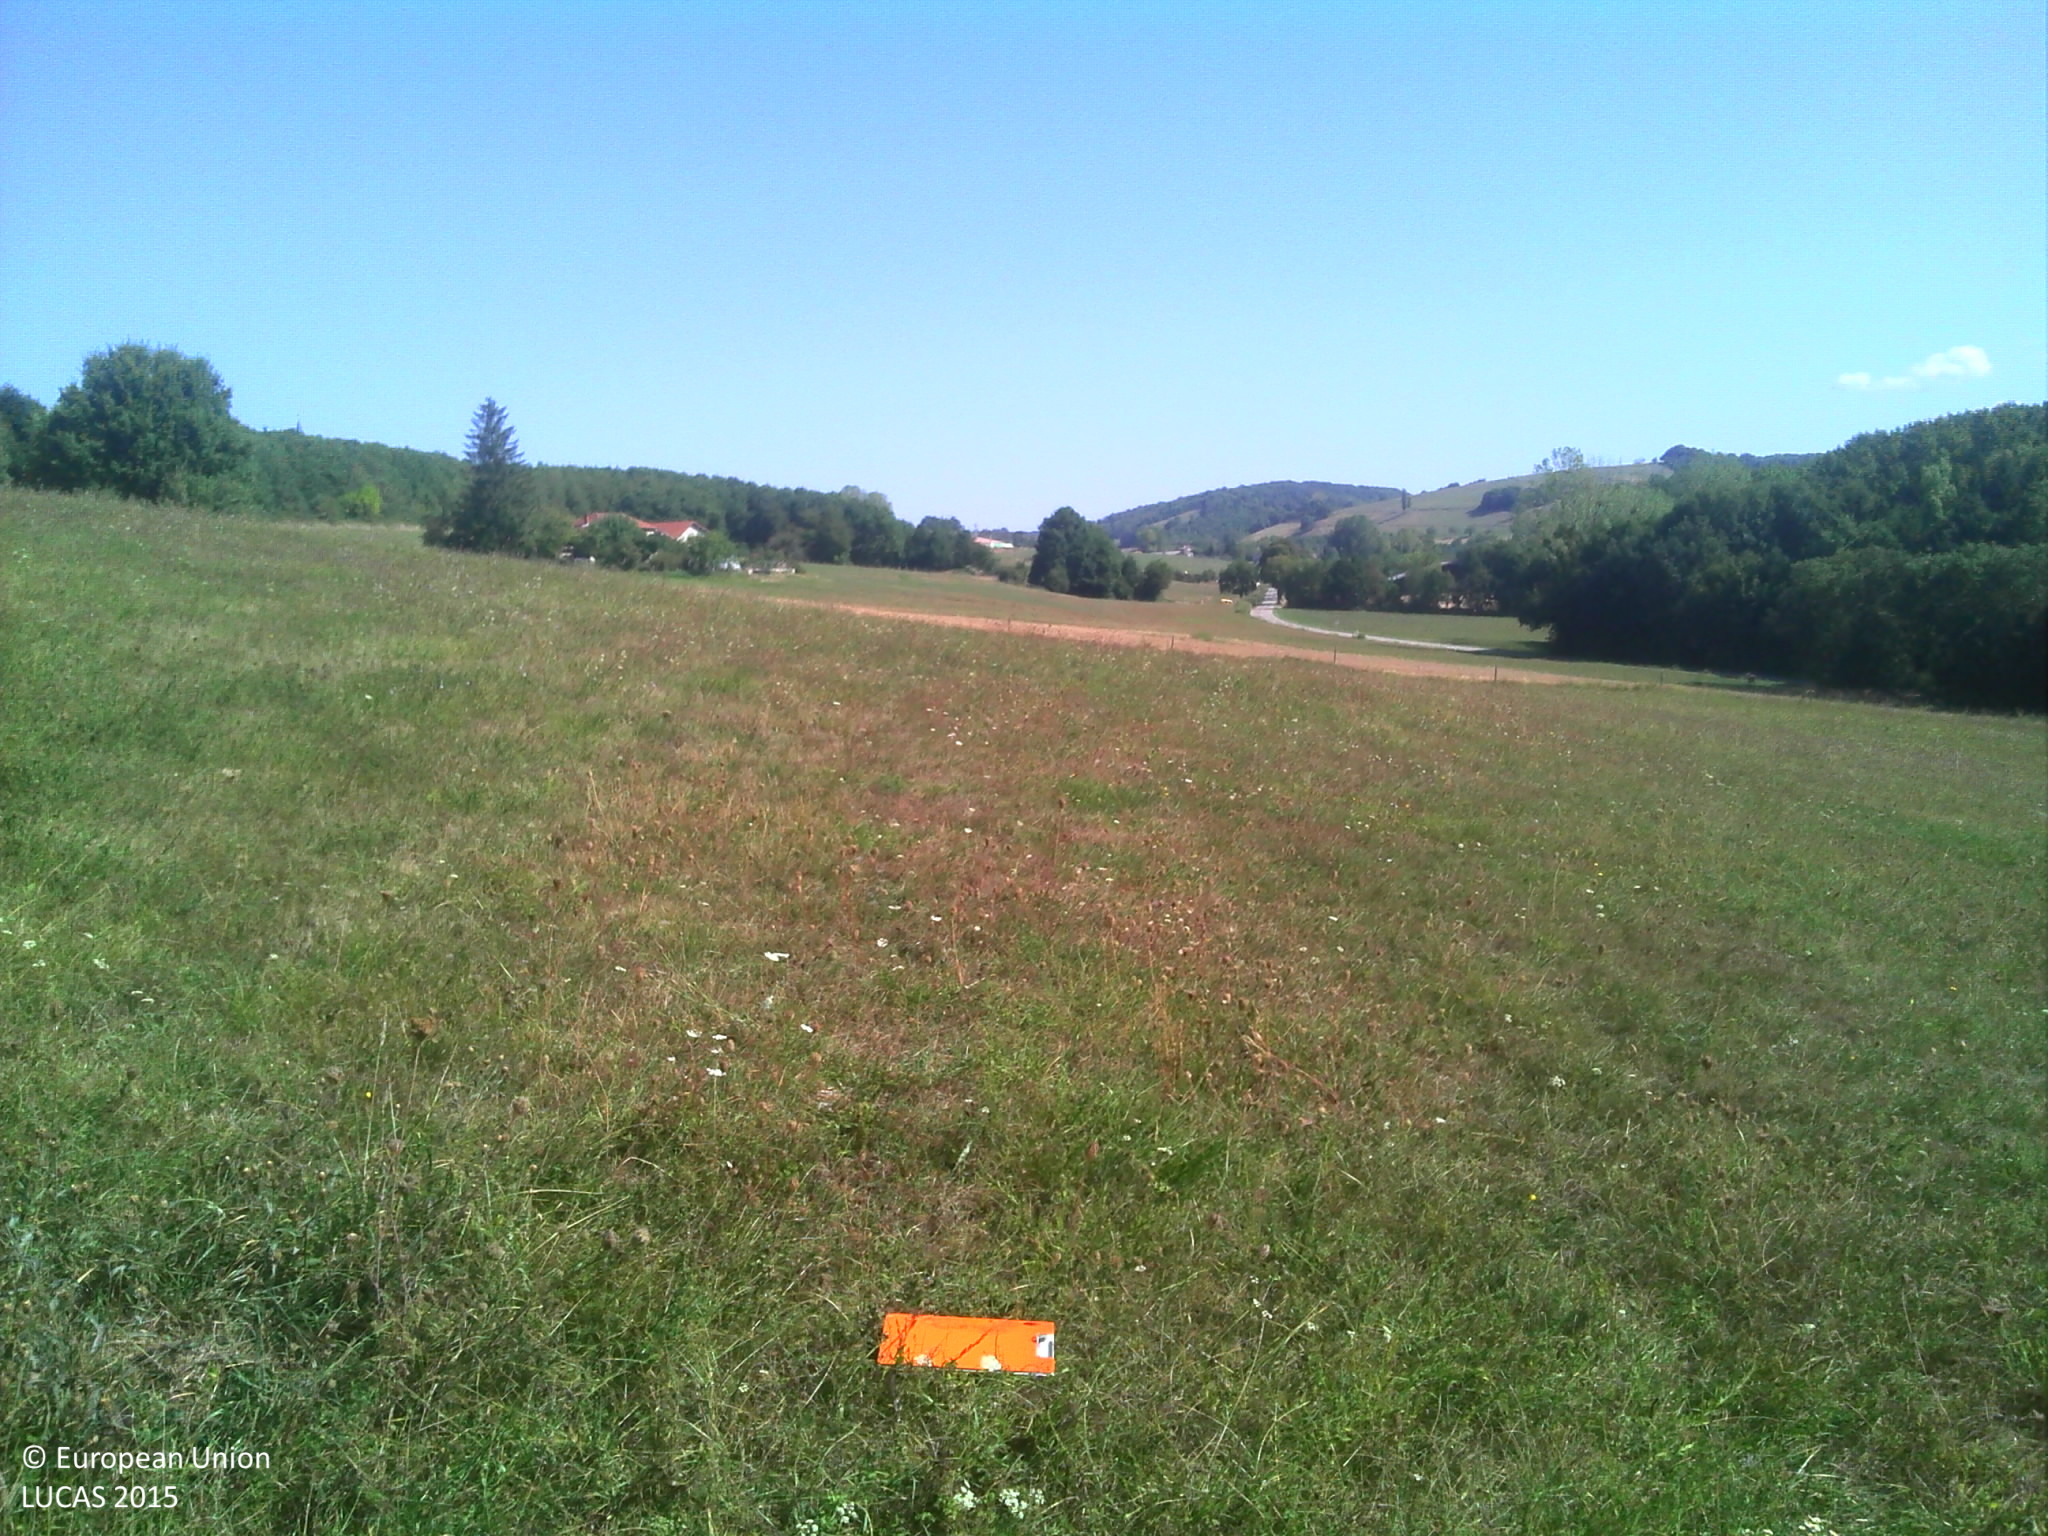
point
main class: Grassland
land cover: Grassland without tree/shrub cover
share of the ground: > 75 %
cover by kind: herbaceous plants 100 %
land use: Agriculture (excluding fallow land and kitchen gardens)
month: September
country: FR
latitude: 45.2114
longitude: 5.1285
